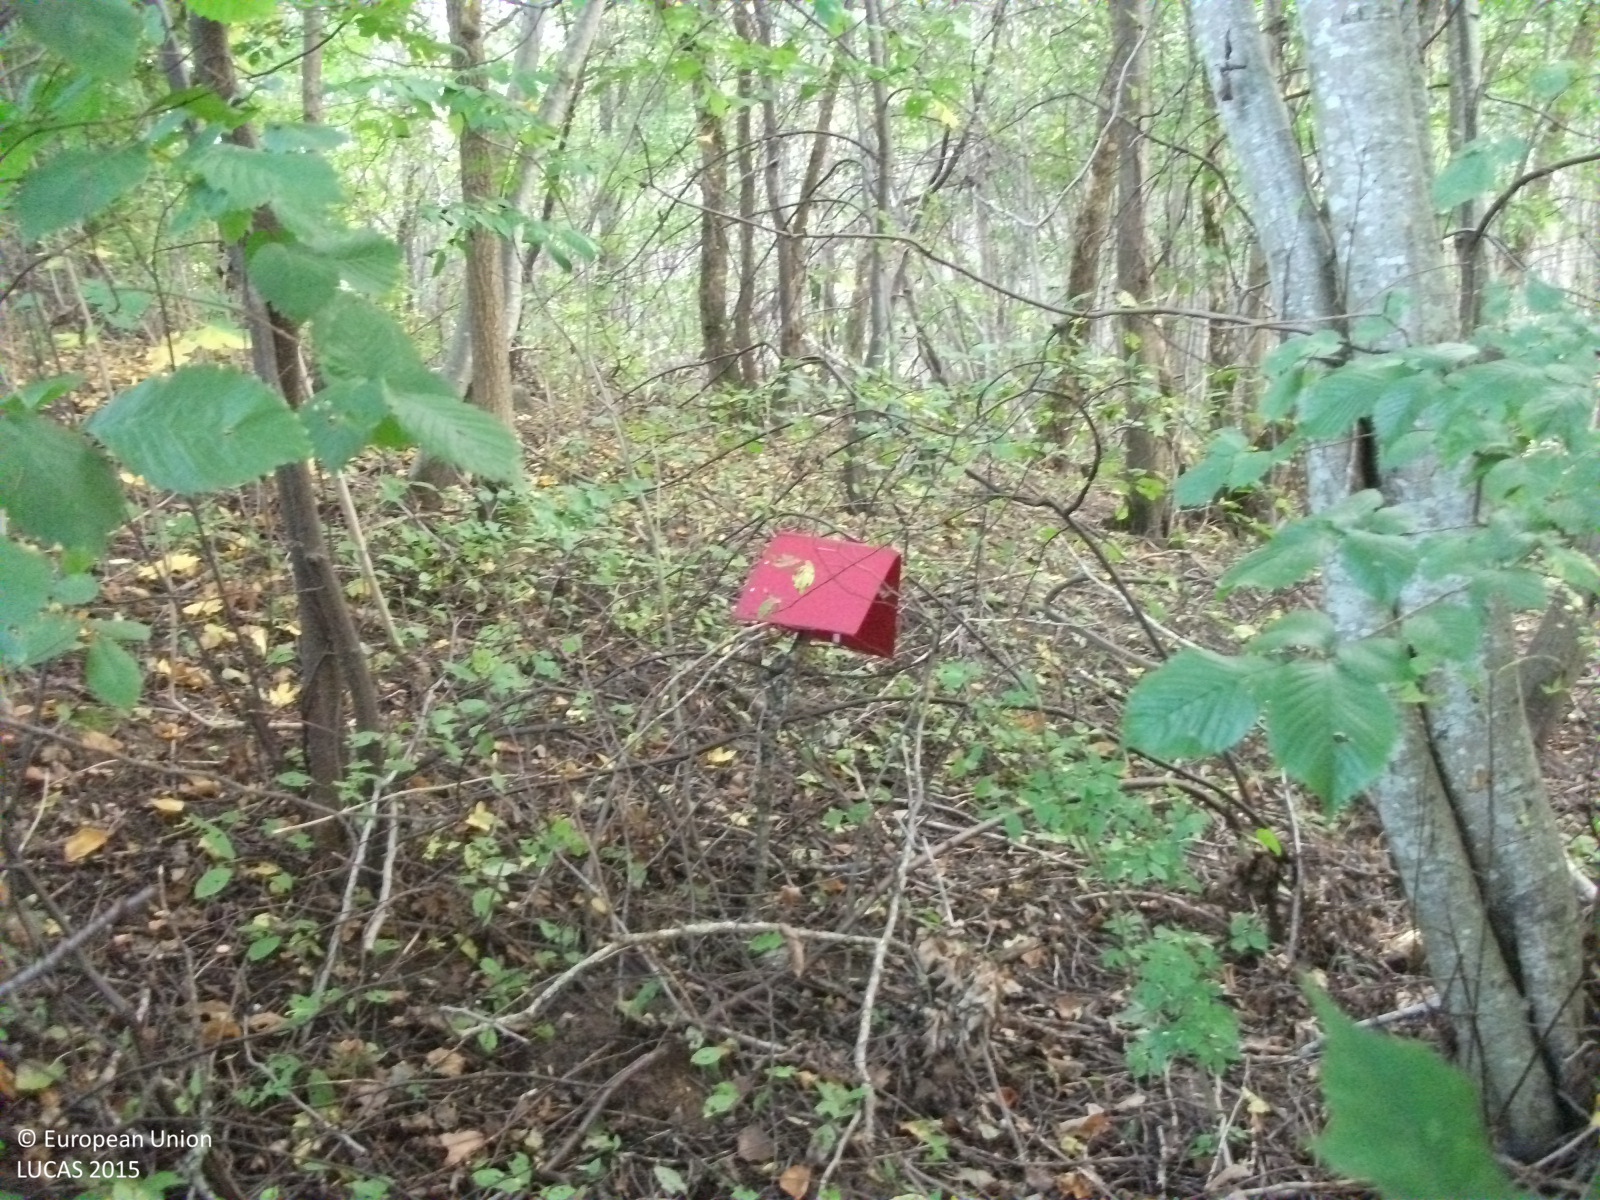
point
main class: Woodland
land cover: Broadleaved woodland
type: non-riverine alder, birch or aspen forest
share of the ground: > 75 %
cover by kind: broadleaved forest trees 90 %, herbaceous plants 5 %, unconsolidated bare surface 5 %
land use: Semi-natural and natural areas not in use
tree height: > 5 m
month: September
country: LV
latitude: 57.8872
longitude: 24.6477
